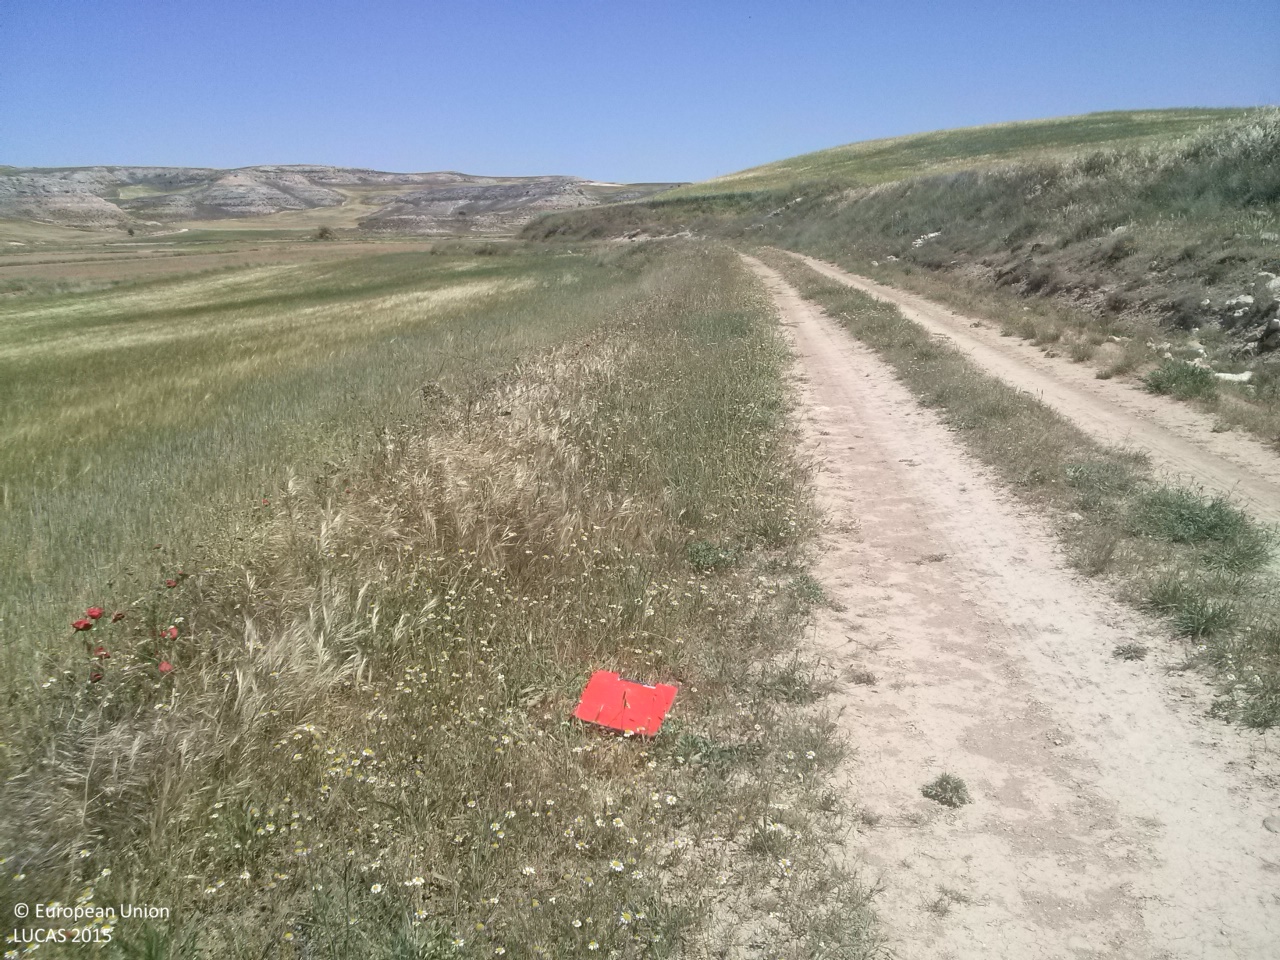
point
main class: Cropland
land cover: Barley
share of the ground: > 75 %
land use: Agriculture (excluding fallow land and kitchen gardens)
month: May
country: ES
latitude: 40.2929
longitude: -2.5983
